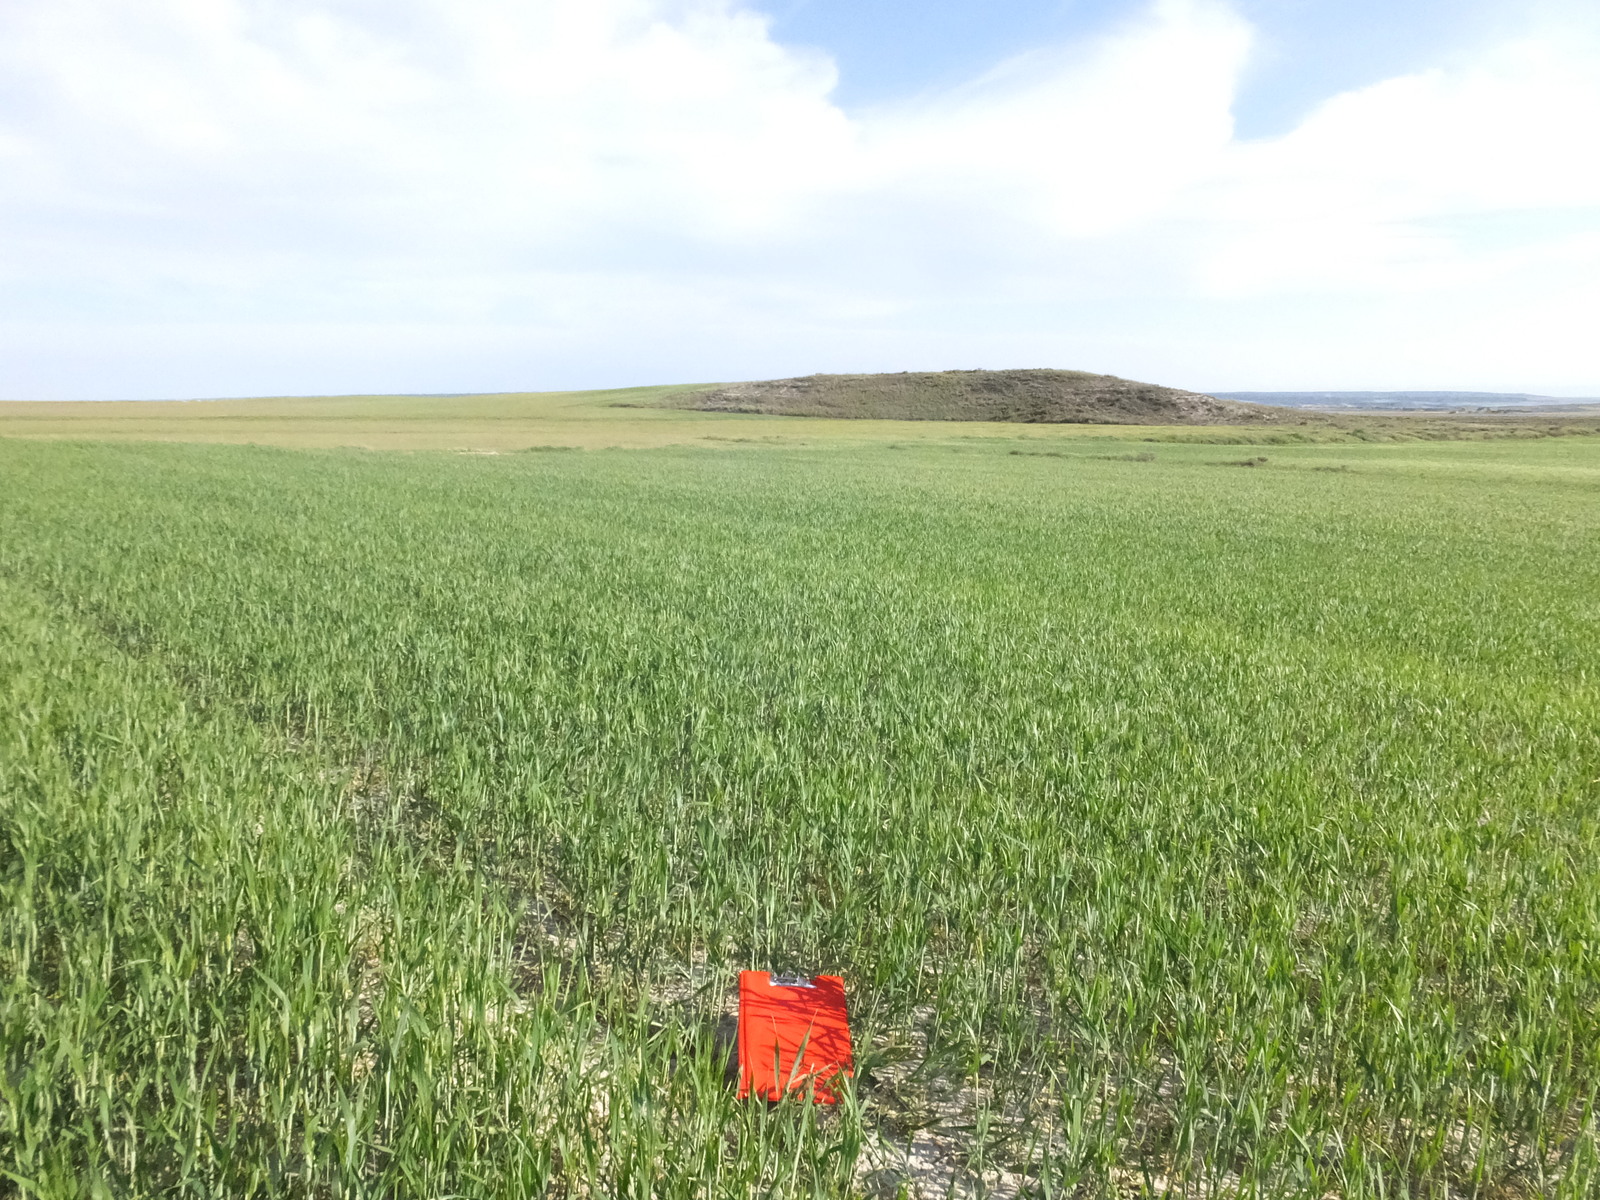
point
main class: Cropland
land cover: Common wheat
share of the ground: > 75 %
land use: Agriculture (excluding fallow land and kitchen gardens)
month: April
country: ES
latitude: 41.5617
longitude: -0.3172
